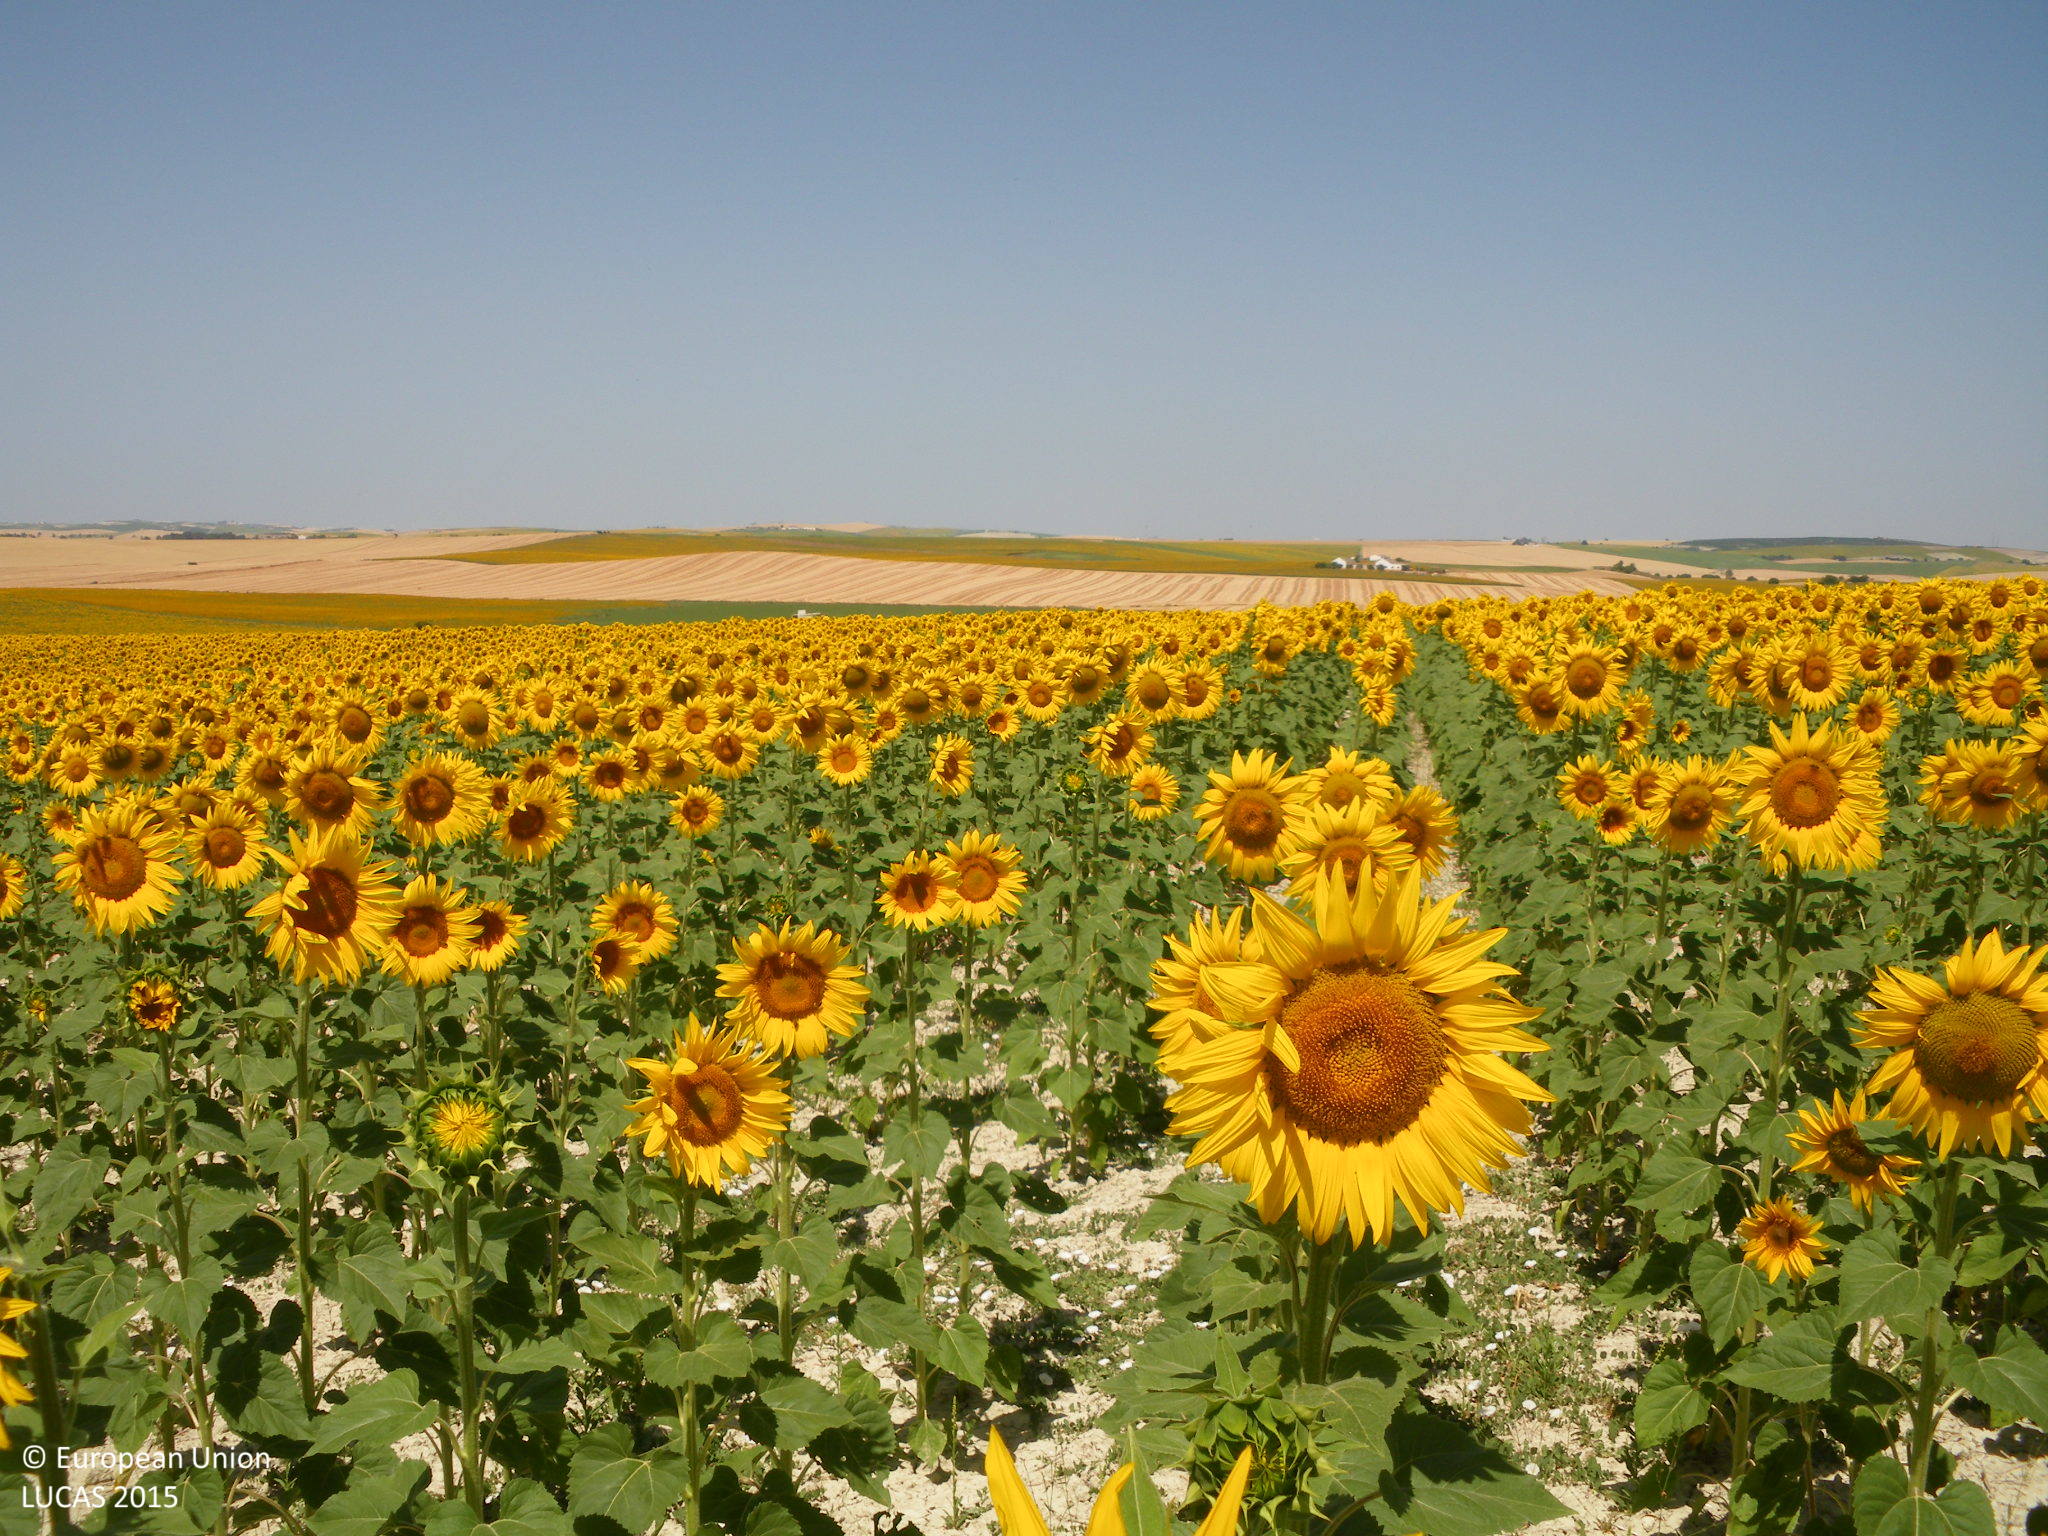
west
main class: Cropland
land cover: Sunflower
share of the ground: > 75 %
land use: Agriculture (excluding fallow land and kitchen gardens)
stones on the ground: < 10 %
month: June
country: ES
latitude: 36.7885
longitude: -6.0032
